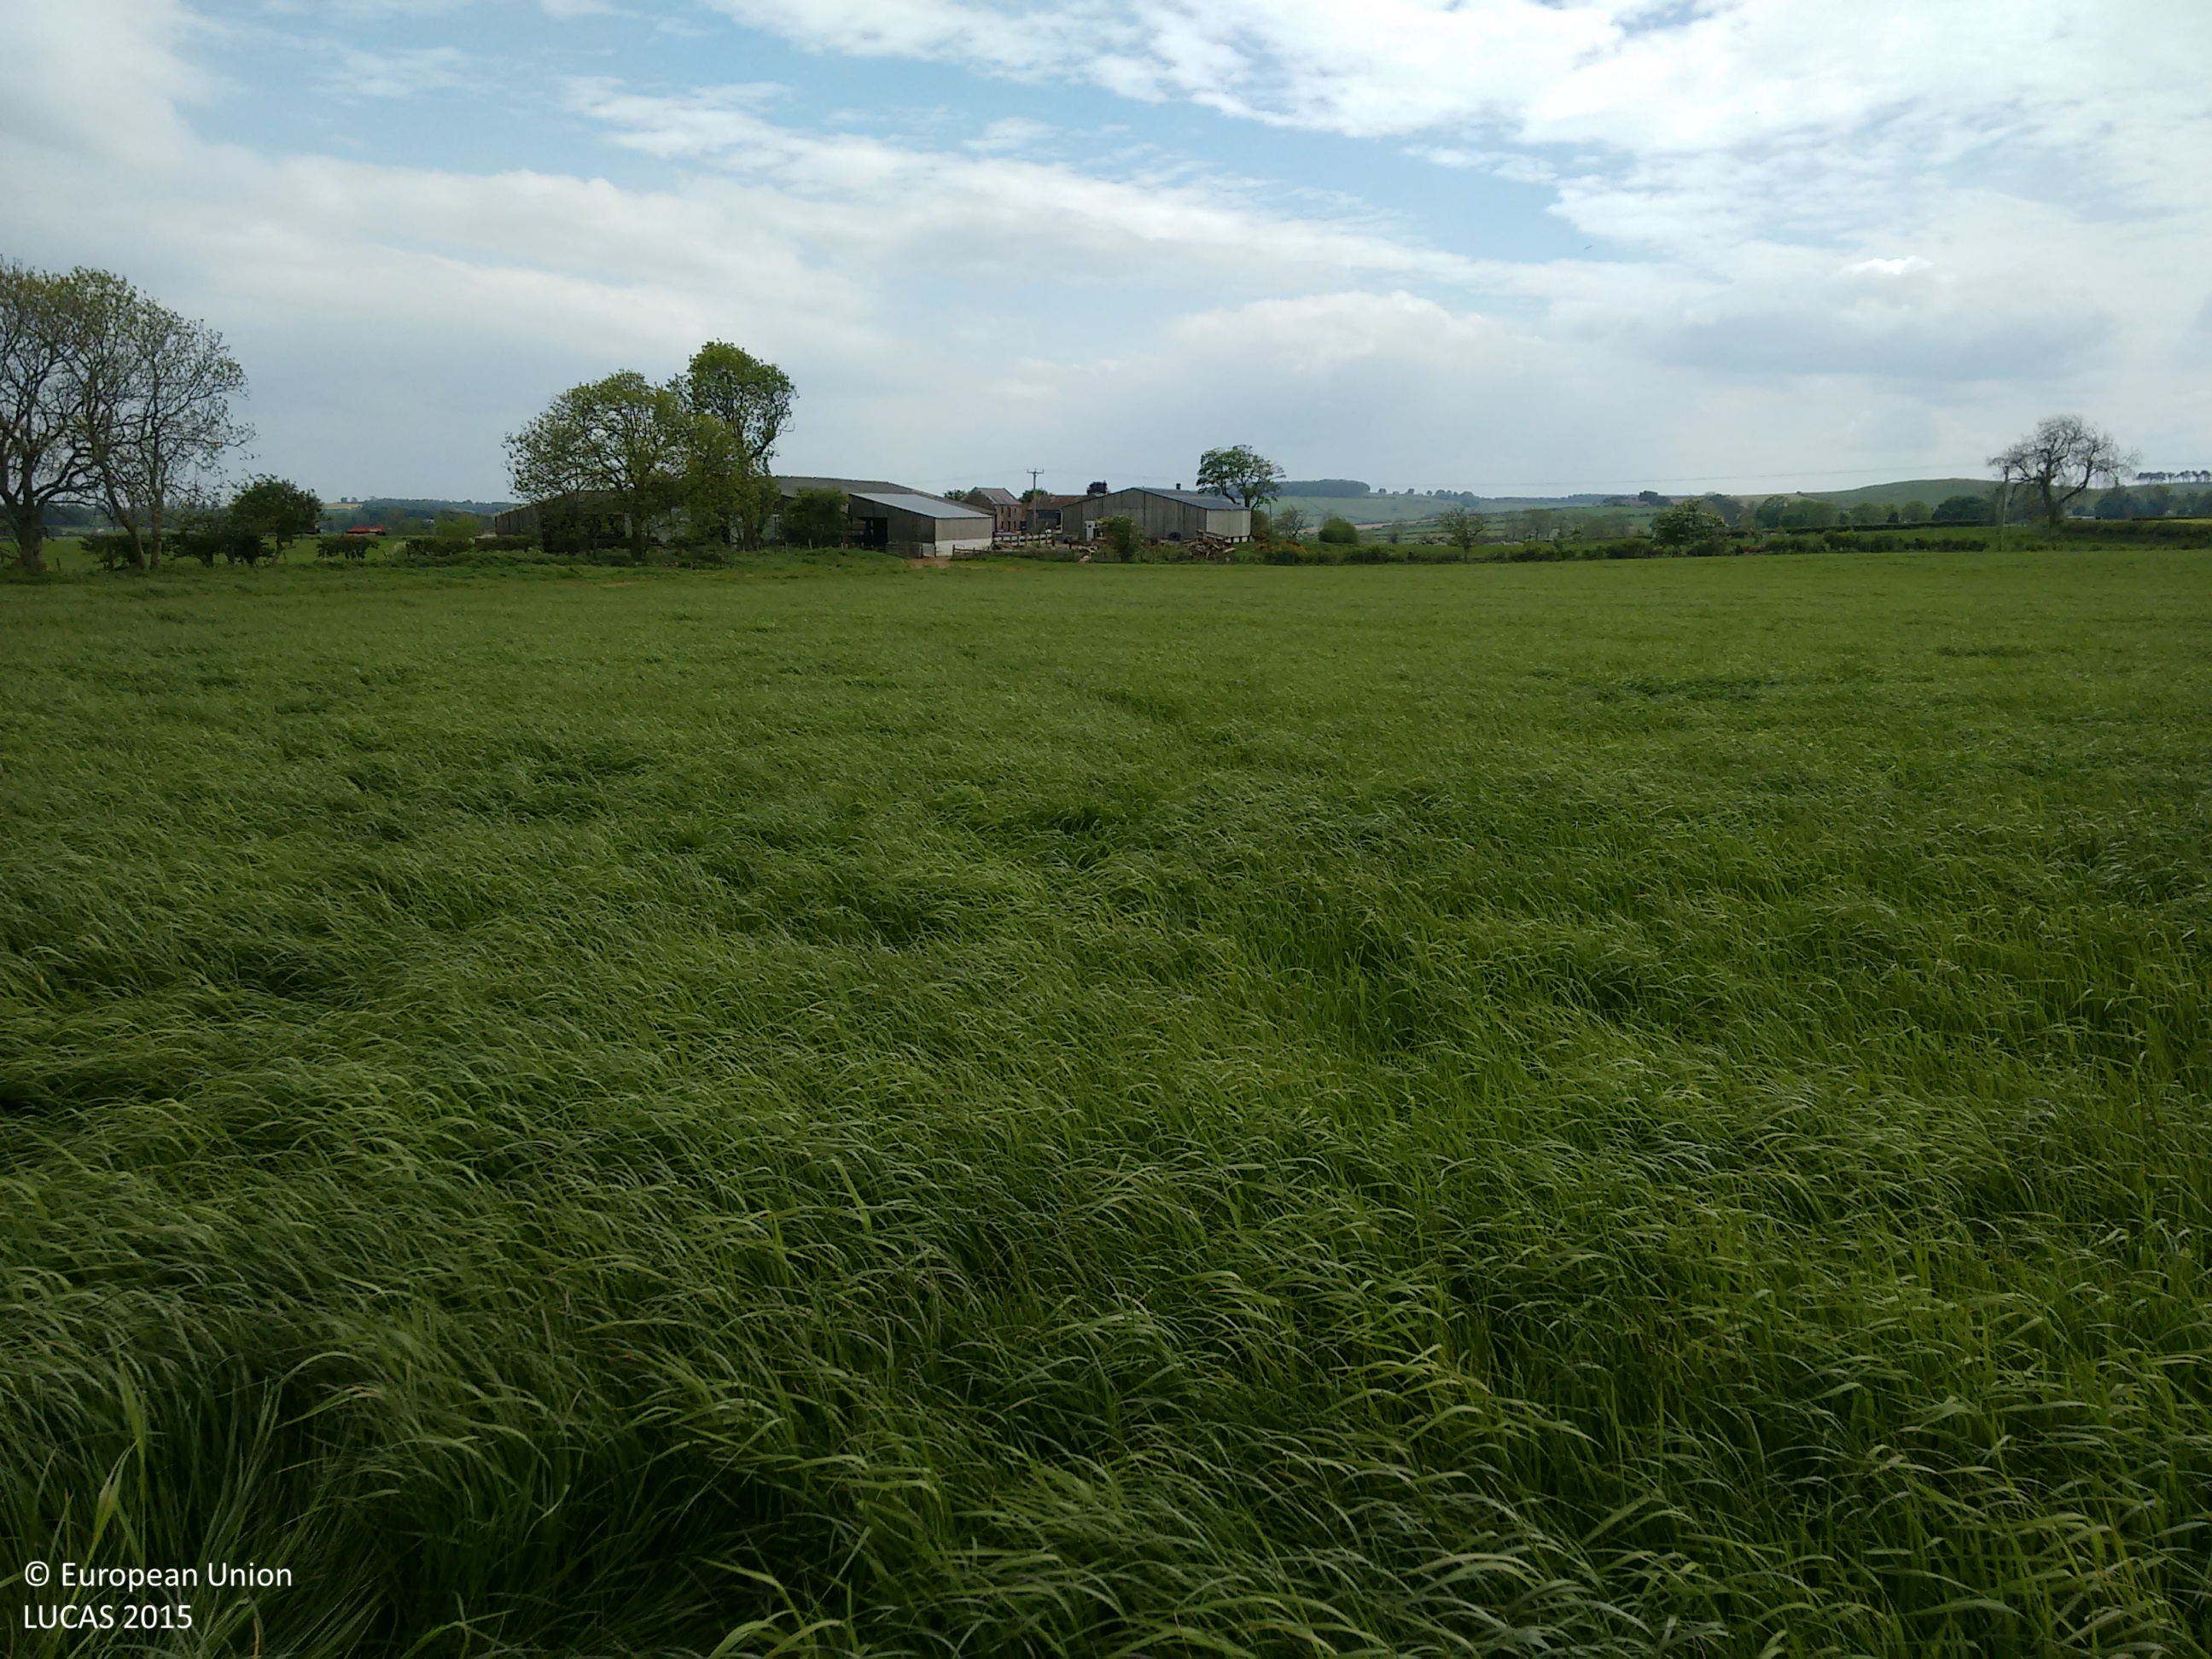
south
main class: Cropland
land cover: Temporary grasslands
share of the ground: > 75 %
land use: Agriculture (excluding fallow land and kitchen gardens)
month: June
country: GB
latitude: 55.4827
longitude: -1.7431
